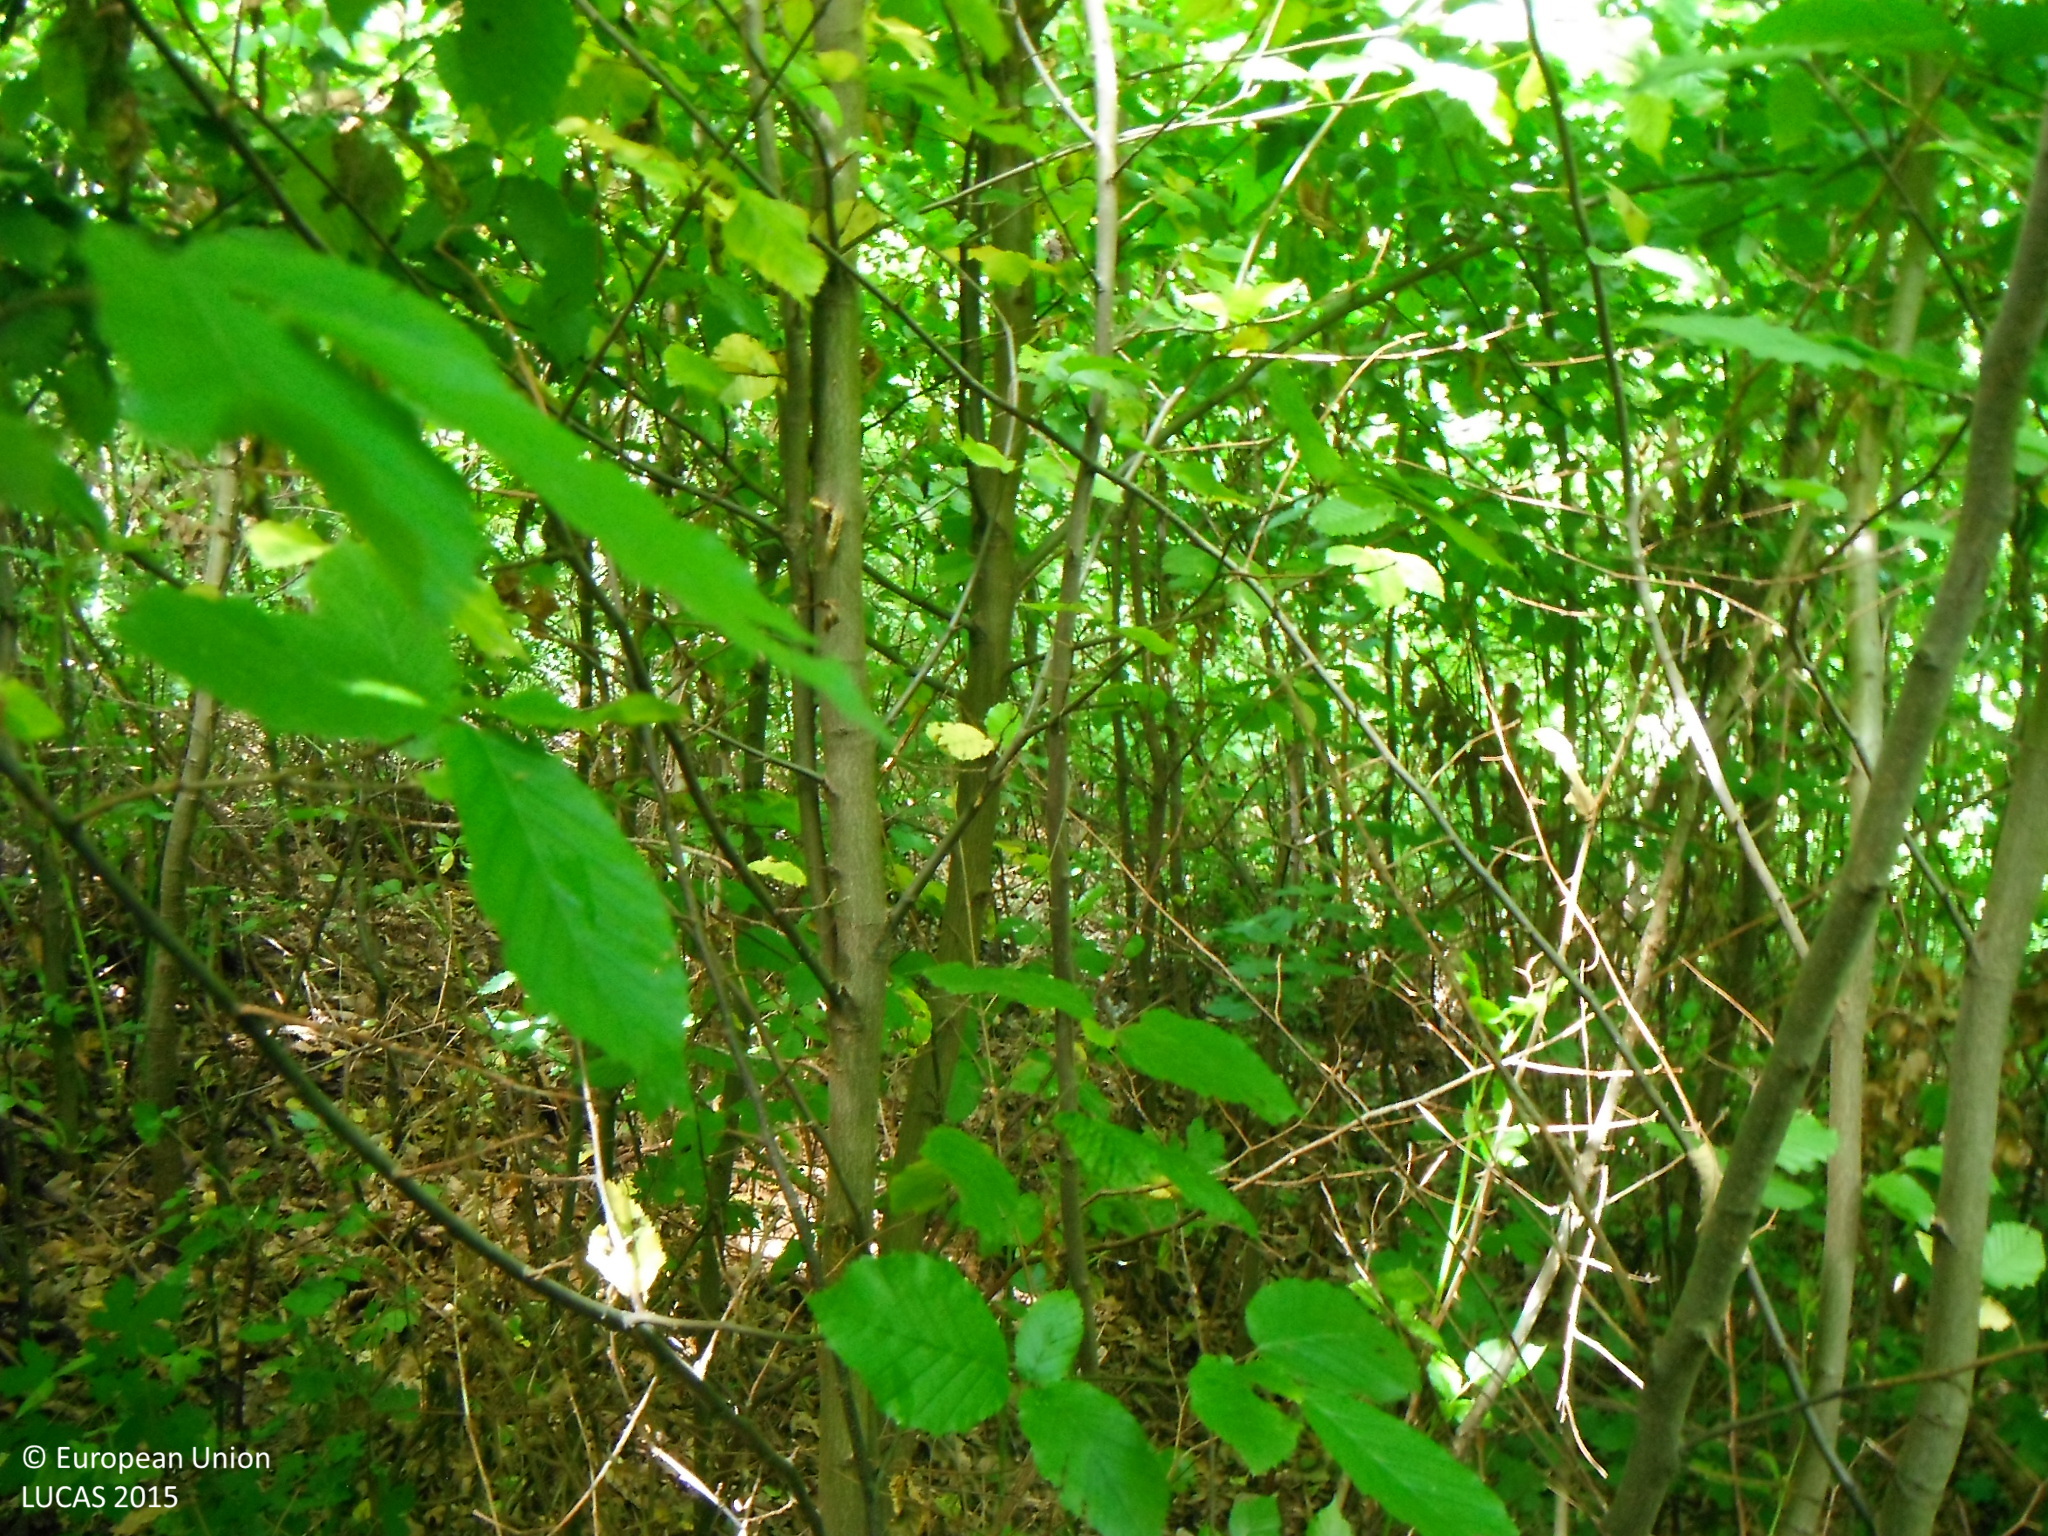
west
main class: Woodland
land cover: Broadleaved woodland
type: mesophytic deciduous forest
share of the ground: > 75 %
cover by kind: broadleaved forest trees 100 %
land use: Forestry
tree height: > 5 m
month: June
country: SK
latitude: 48.2123
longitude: 19.4847
